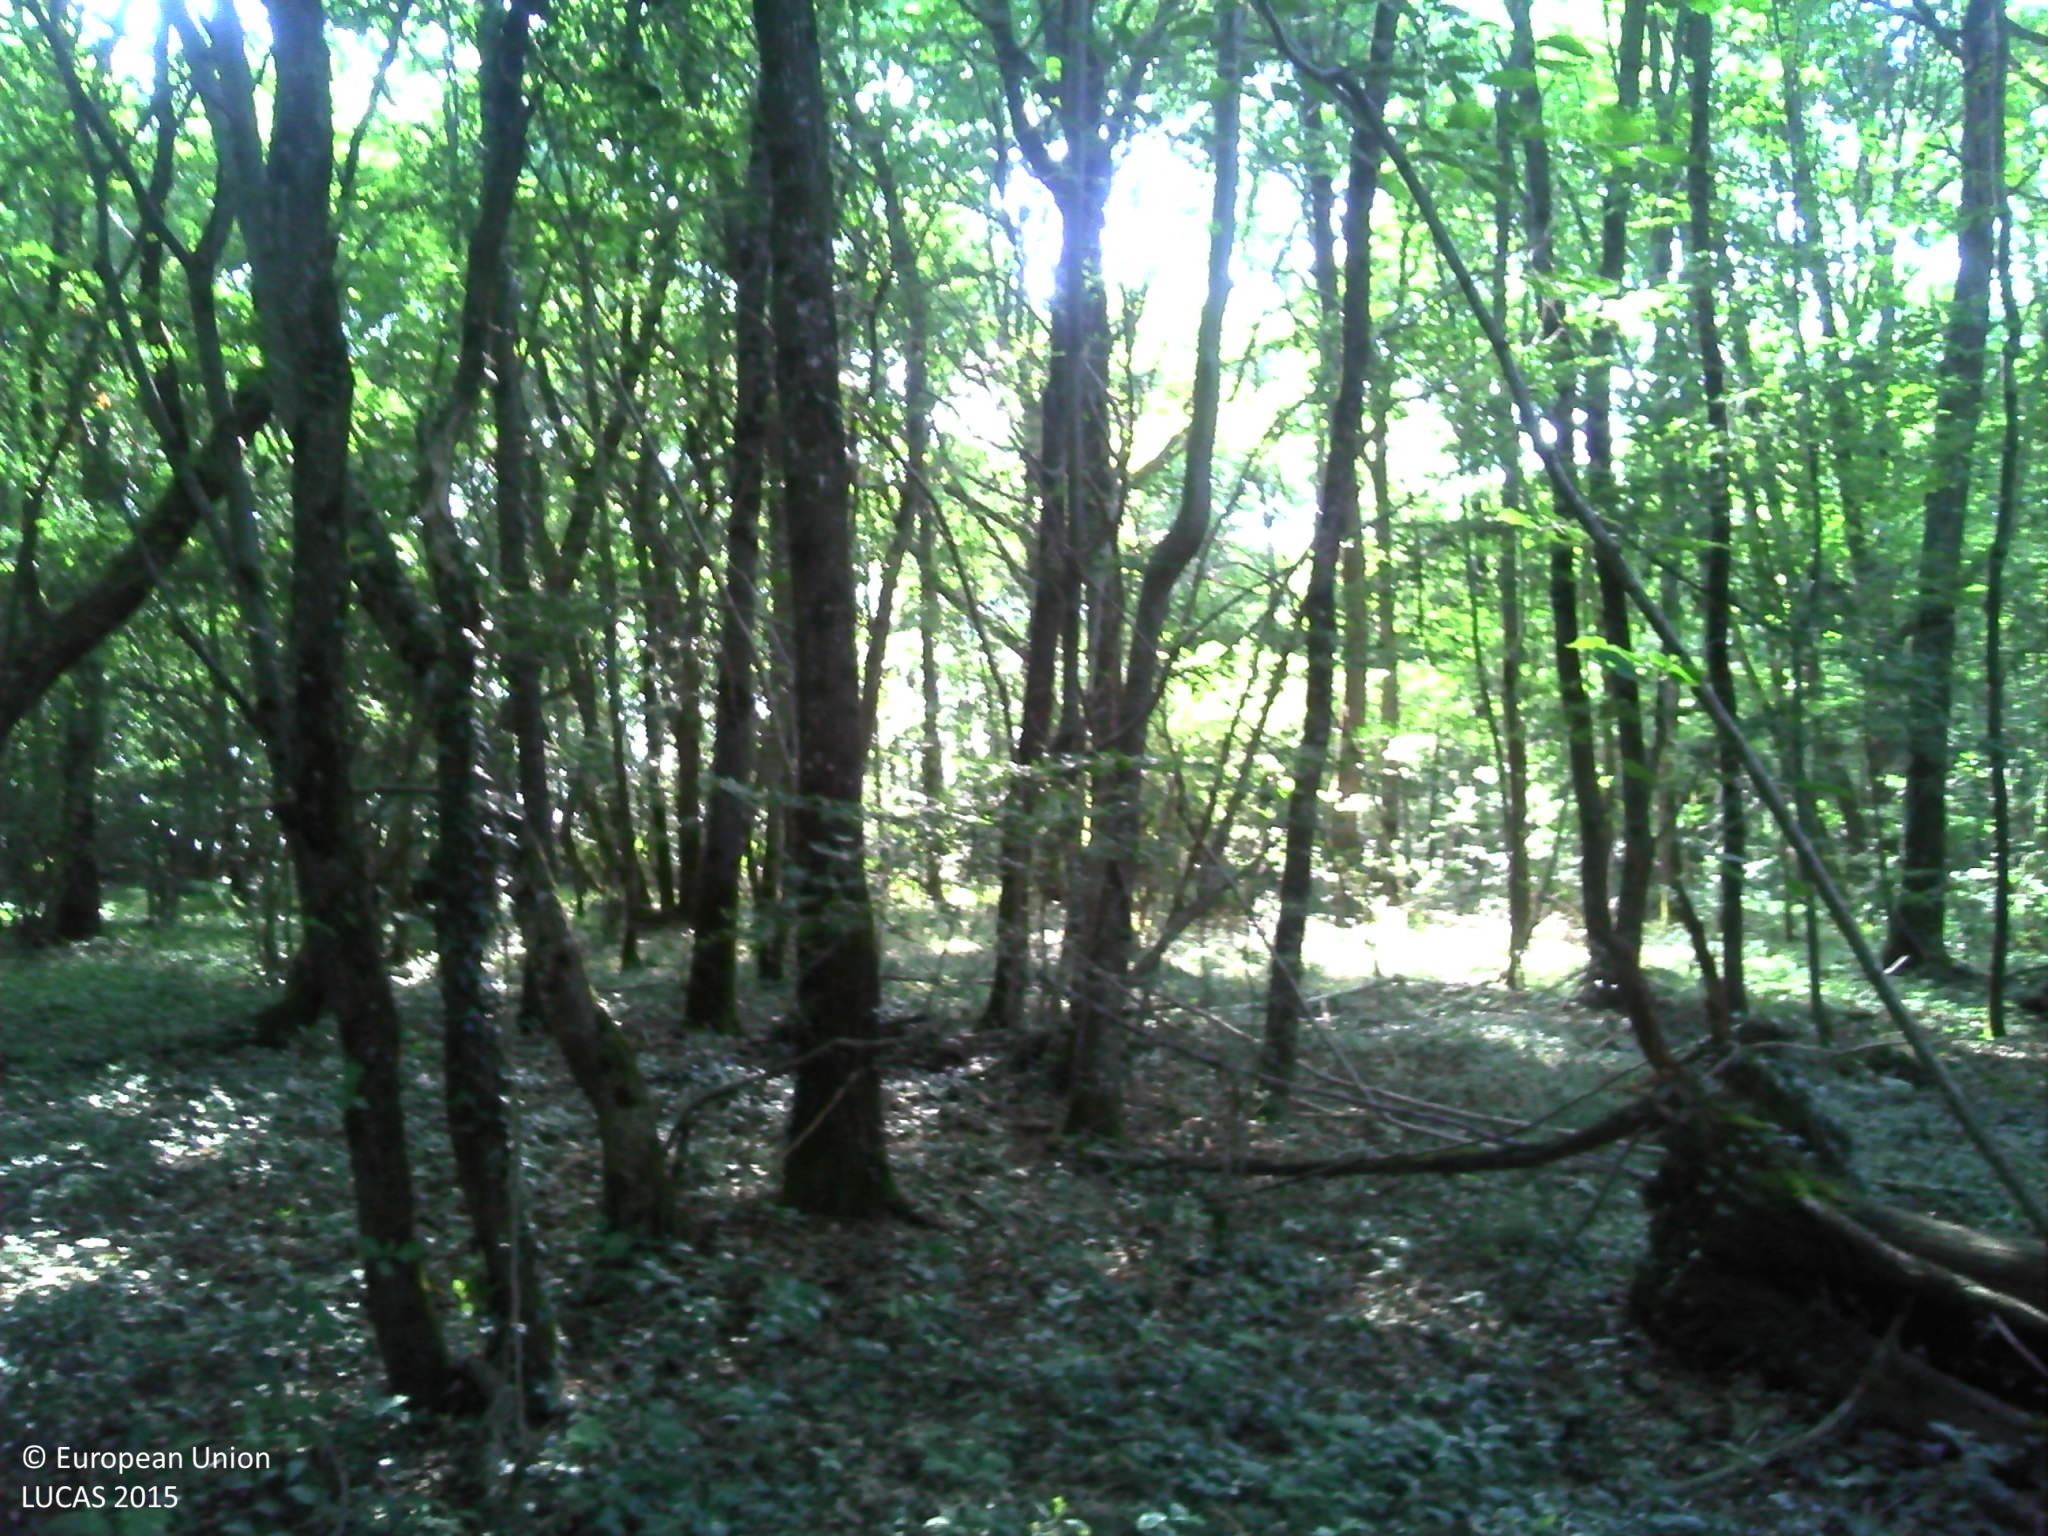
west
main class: Woodland
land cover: Broadleaved woodland
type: mesophytic deciduous forest
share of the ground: > 75 %
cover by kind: broadleaved forest trees 95 %, herbaceous plants 5 %
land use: Forestry
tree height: > 5 m
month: June
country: FR
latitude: 47.5977
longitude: 2.6375
